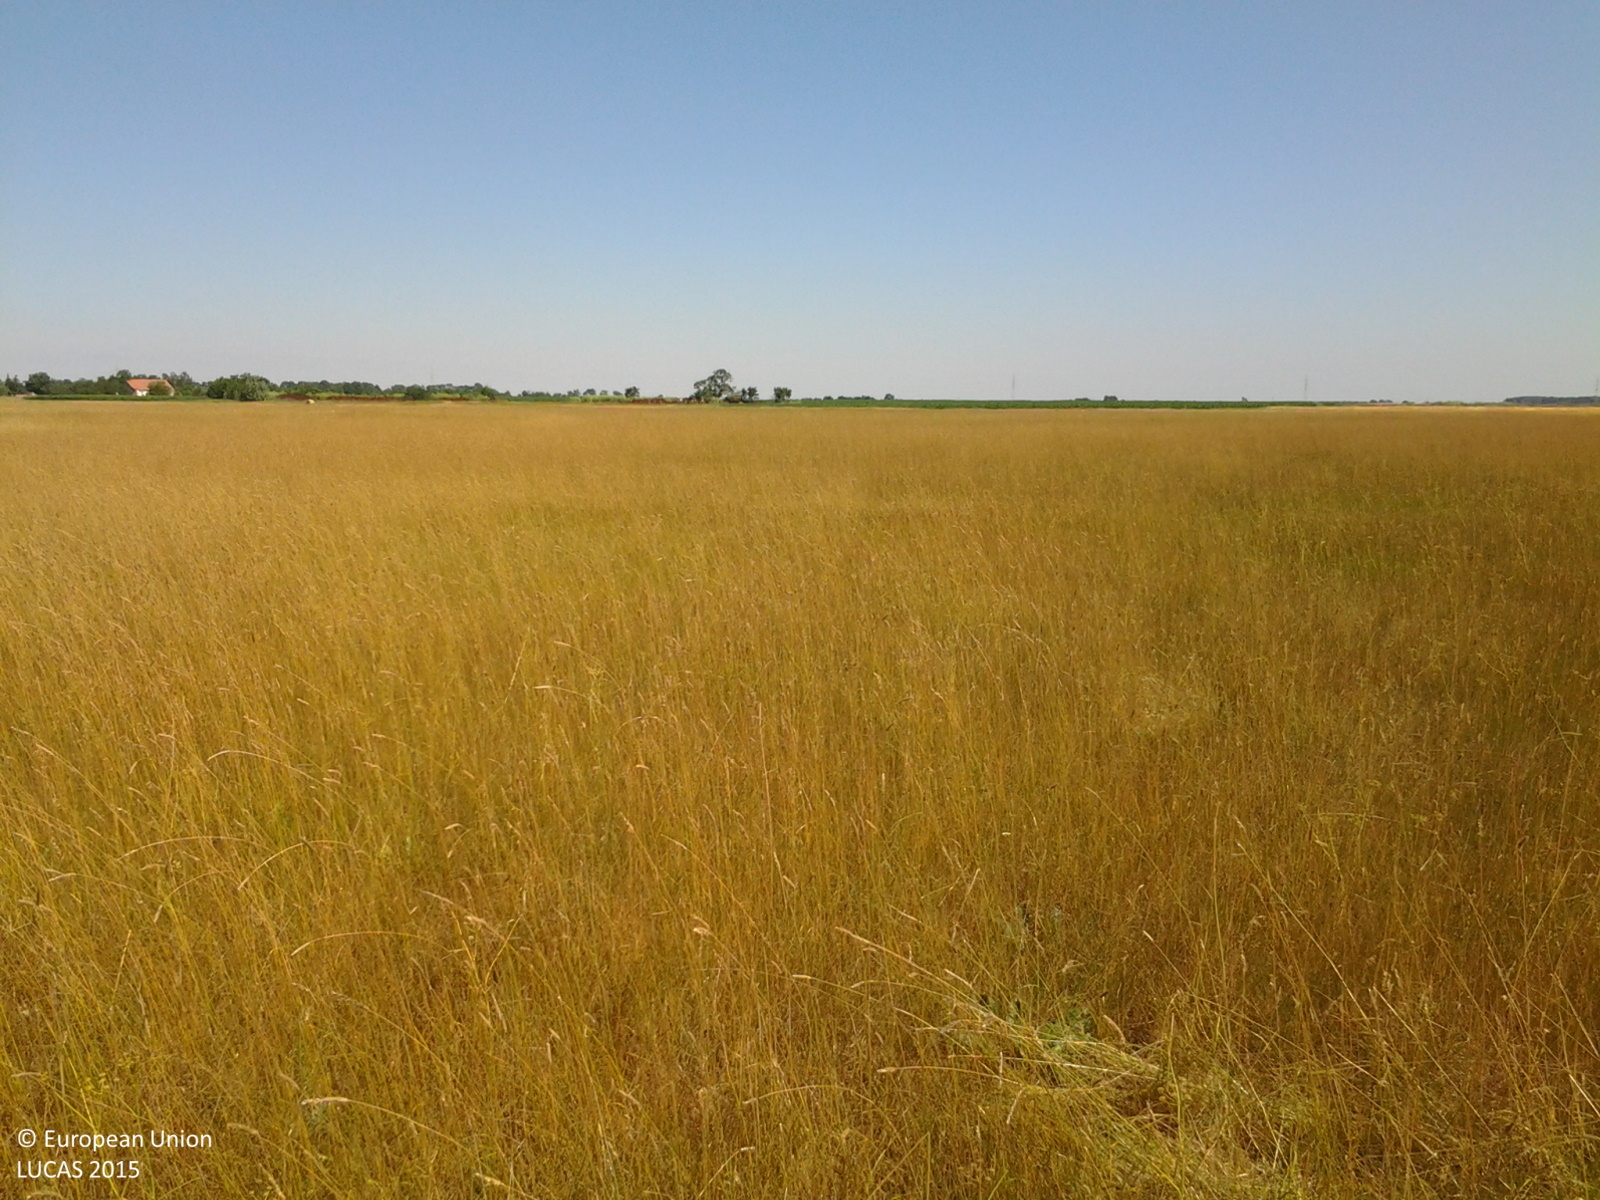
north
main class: Grassland
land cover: Grassland without tree/shrub cover
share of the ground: > 75 %
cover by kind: herbaceous plants 100 %
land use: Agriculture (excluding fallow land and kitchen gardens)
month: June
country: HU
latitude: 46.6003
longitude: 21.1696
